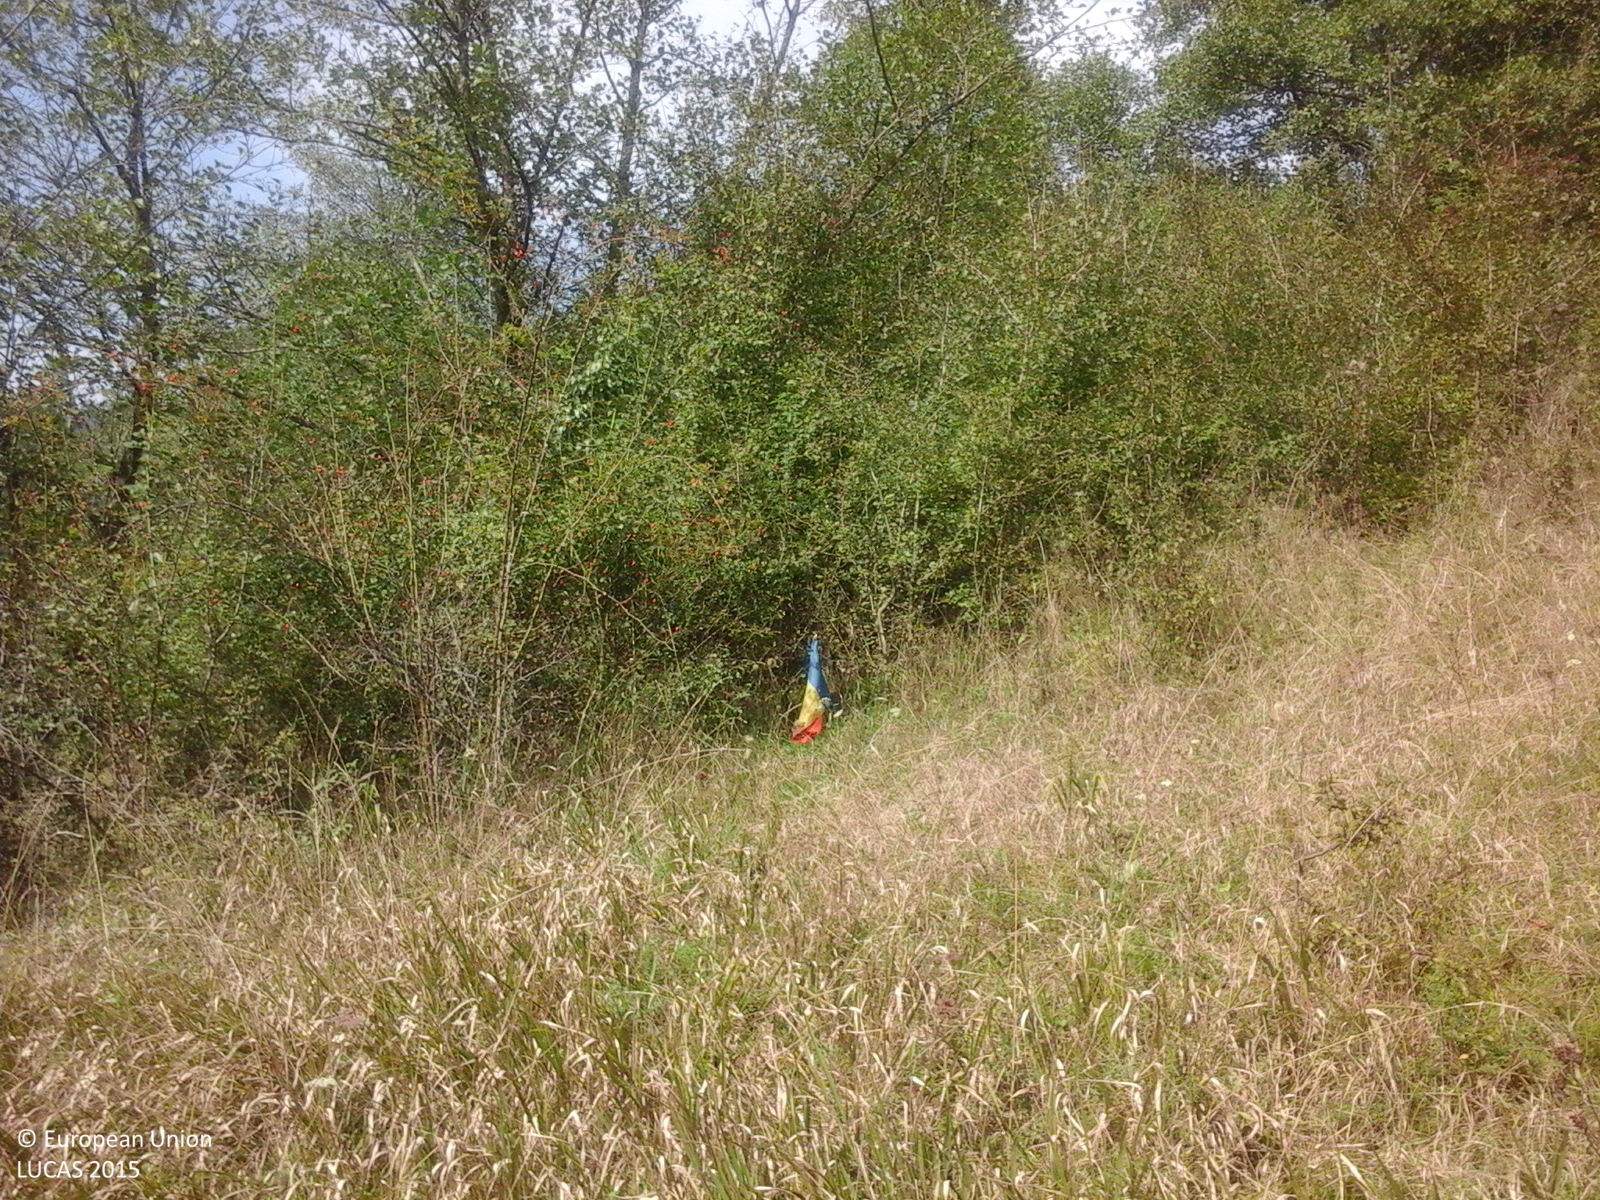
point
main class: Woodland
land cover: Broadleaved woodland
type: beech forest
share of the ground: > 75 %
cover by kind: broadleaved forest trees 100 %
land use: Forestry
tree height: < 5 m
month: September
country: RO
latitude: 47.0164
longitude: 22.9670
